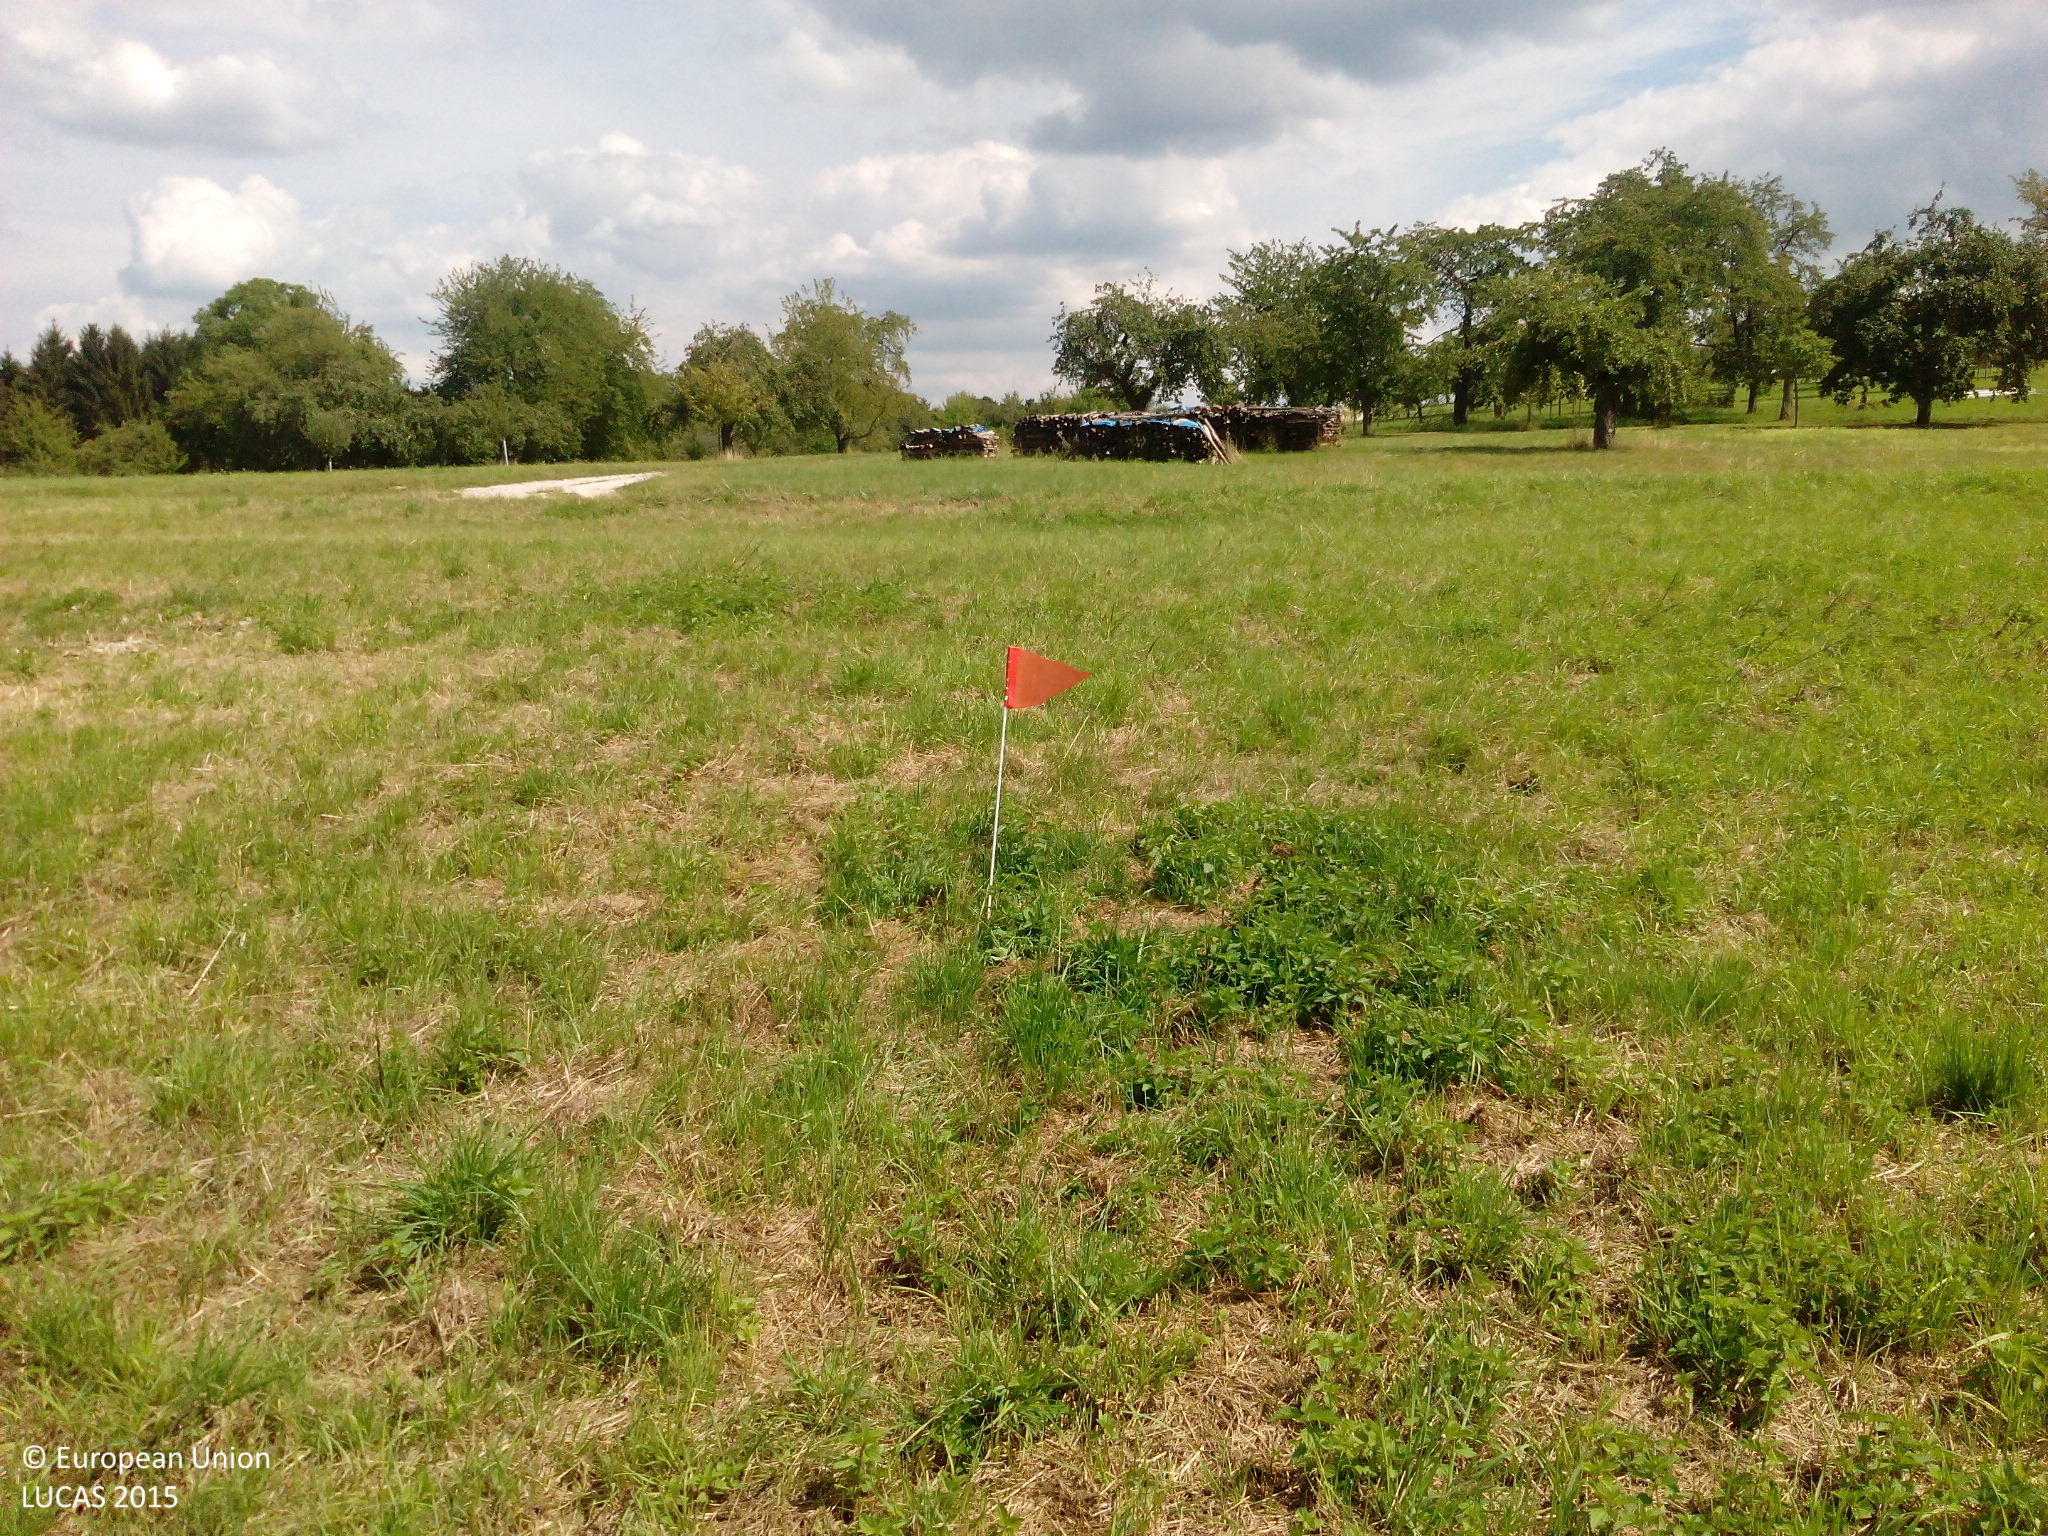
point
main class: Grassland
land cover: Grassland without tree/shrub cover
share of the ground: > 75 %
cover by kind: herbaceous plants 80 %, unconsolidated bare surface 20 %
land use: Agriculture (excluding fallow land and kitchen gardens)
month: August
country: DE
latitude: 50.2107
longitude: 7.4920
